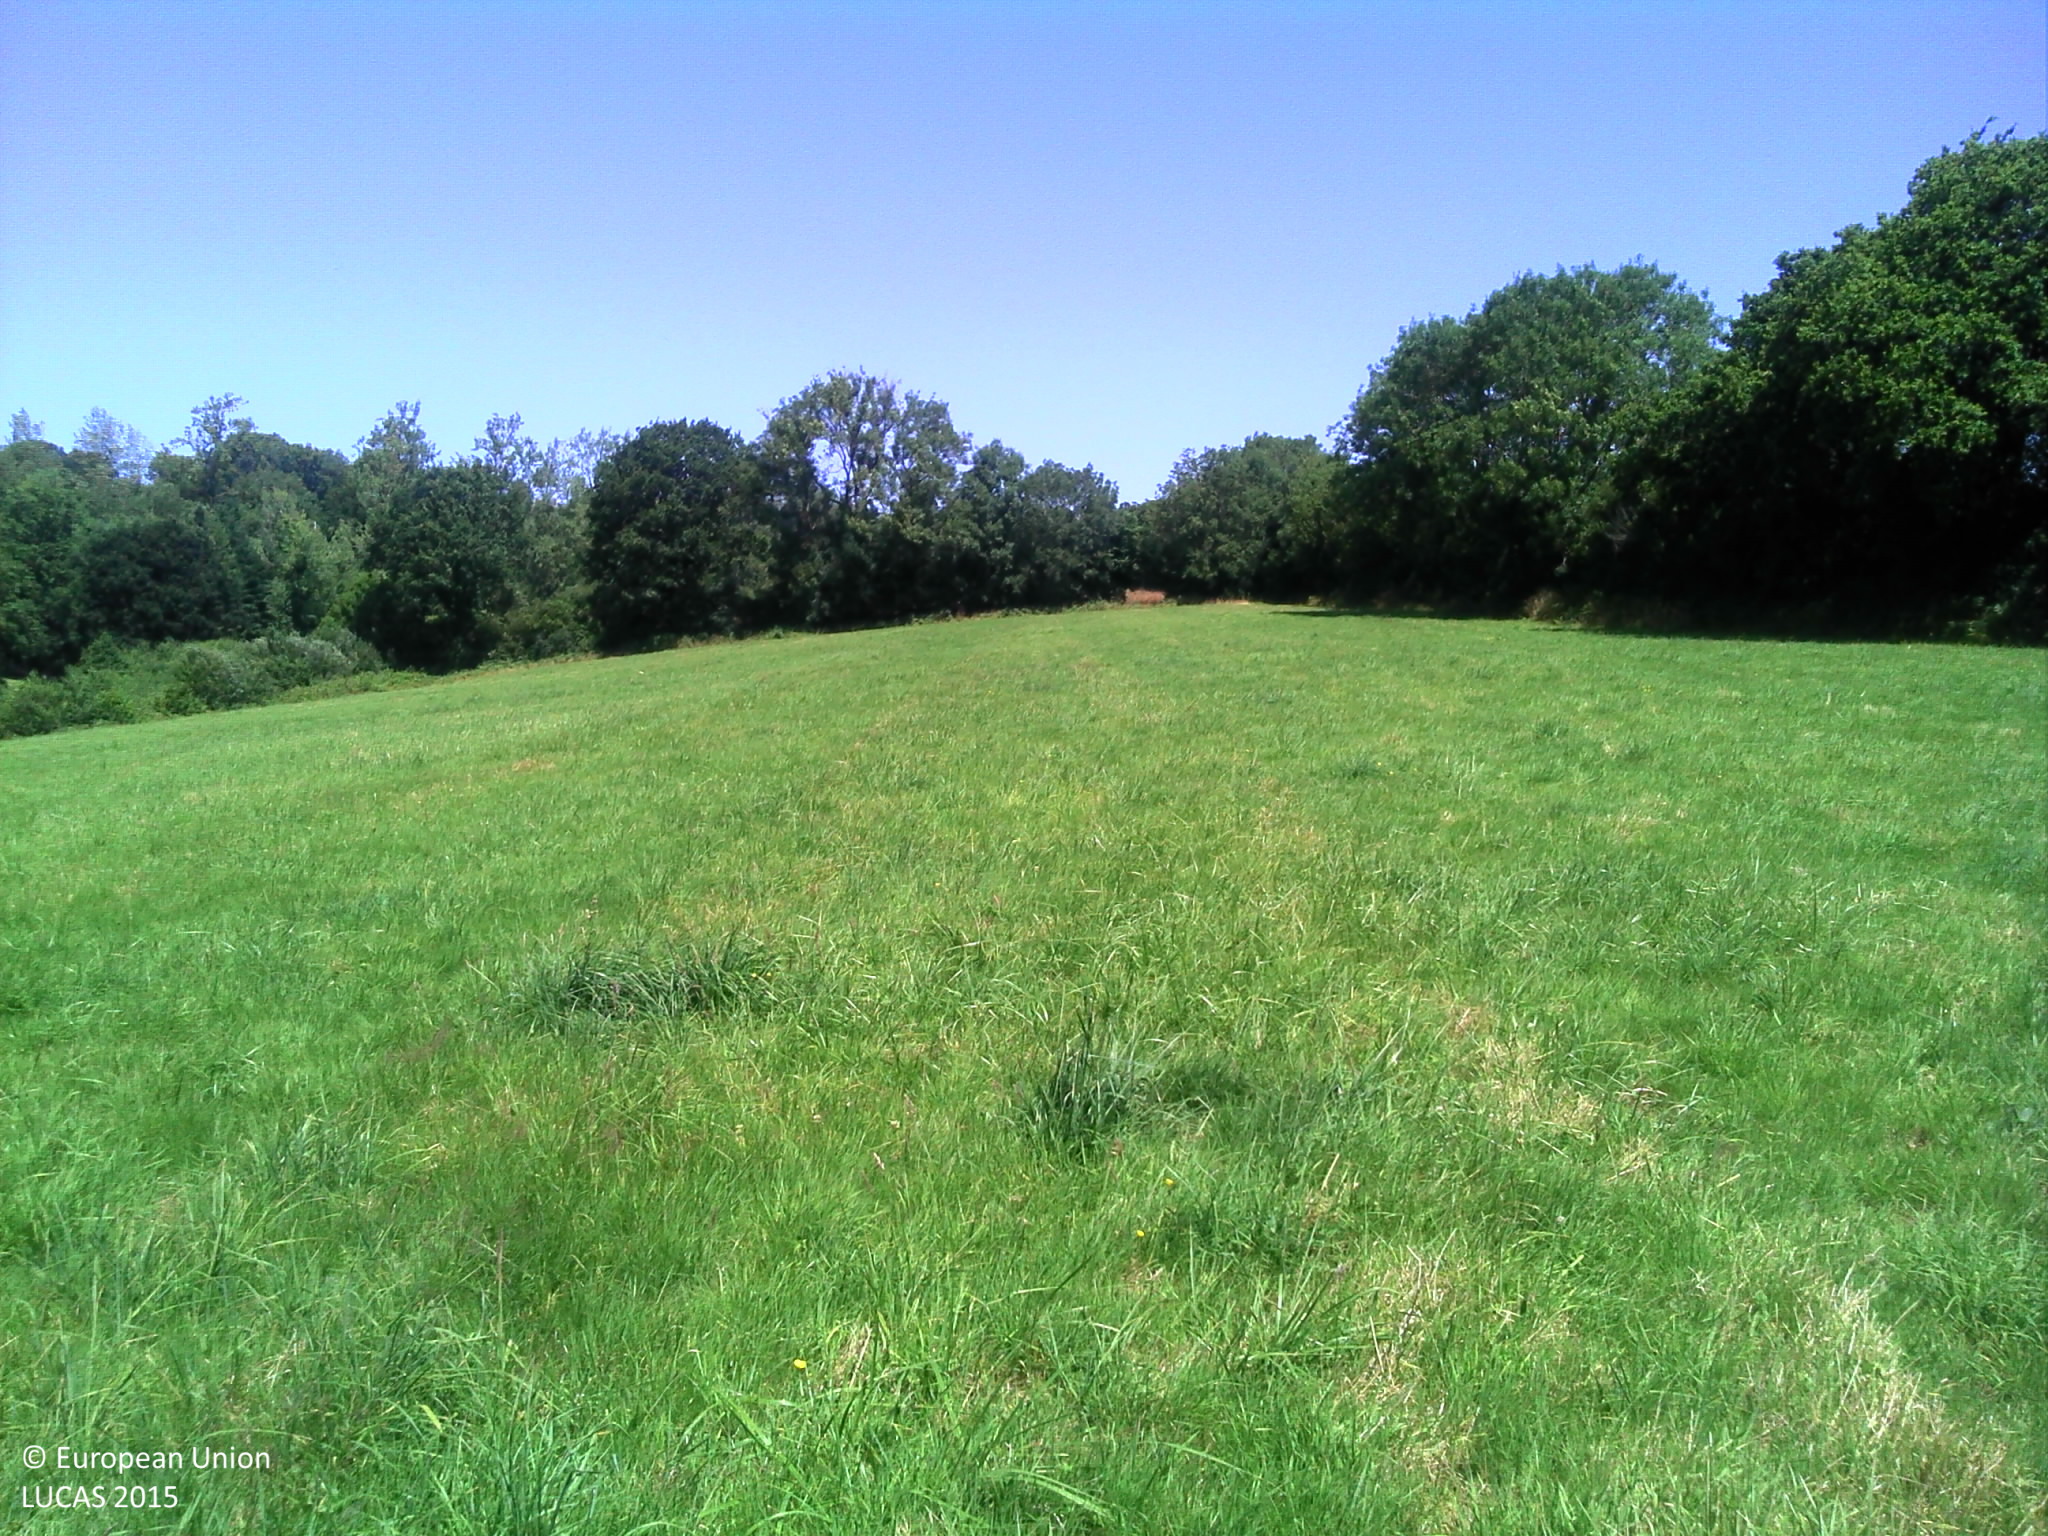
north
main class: Grassland
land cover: Grassland without tree/shrub cover
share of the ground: > 75 %
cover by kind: herbaceous plants 100 %
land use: Agriculture (excluding fallow land and kitchen gardens)
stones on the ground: < 10 %
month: July
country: FR
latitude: 49.0455
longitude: -1.4166
